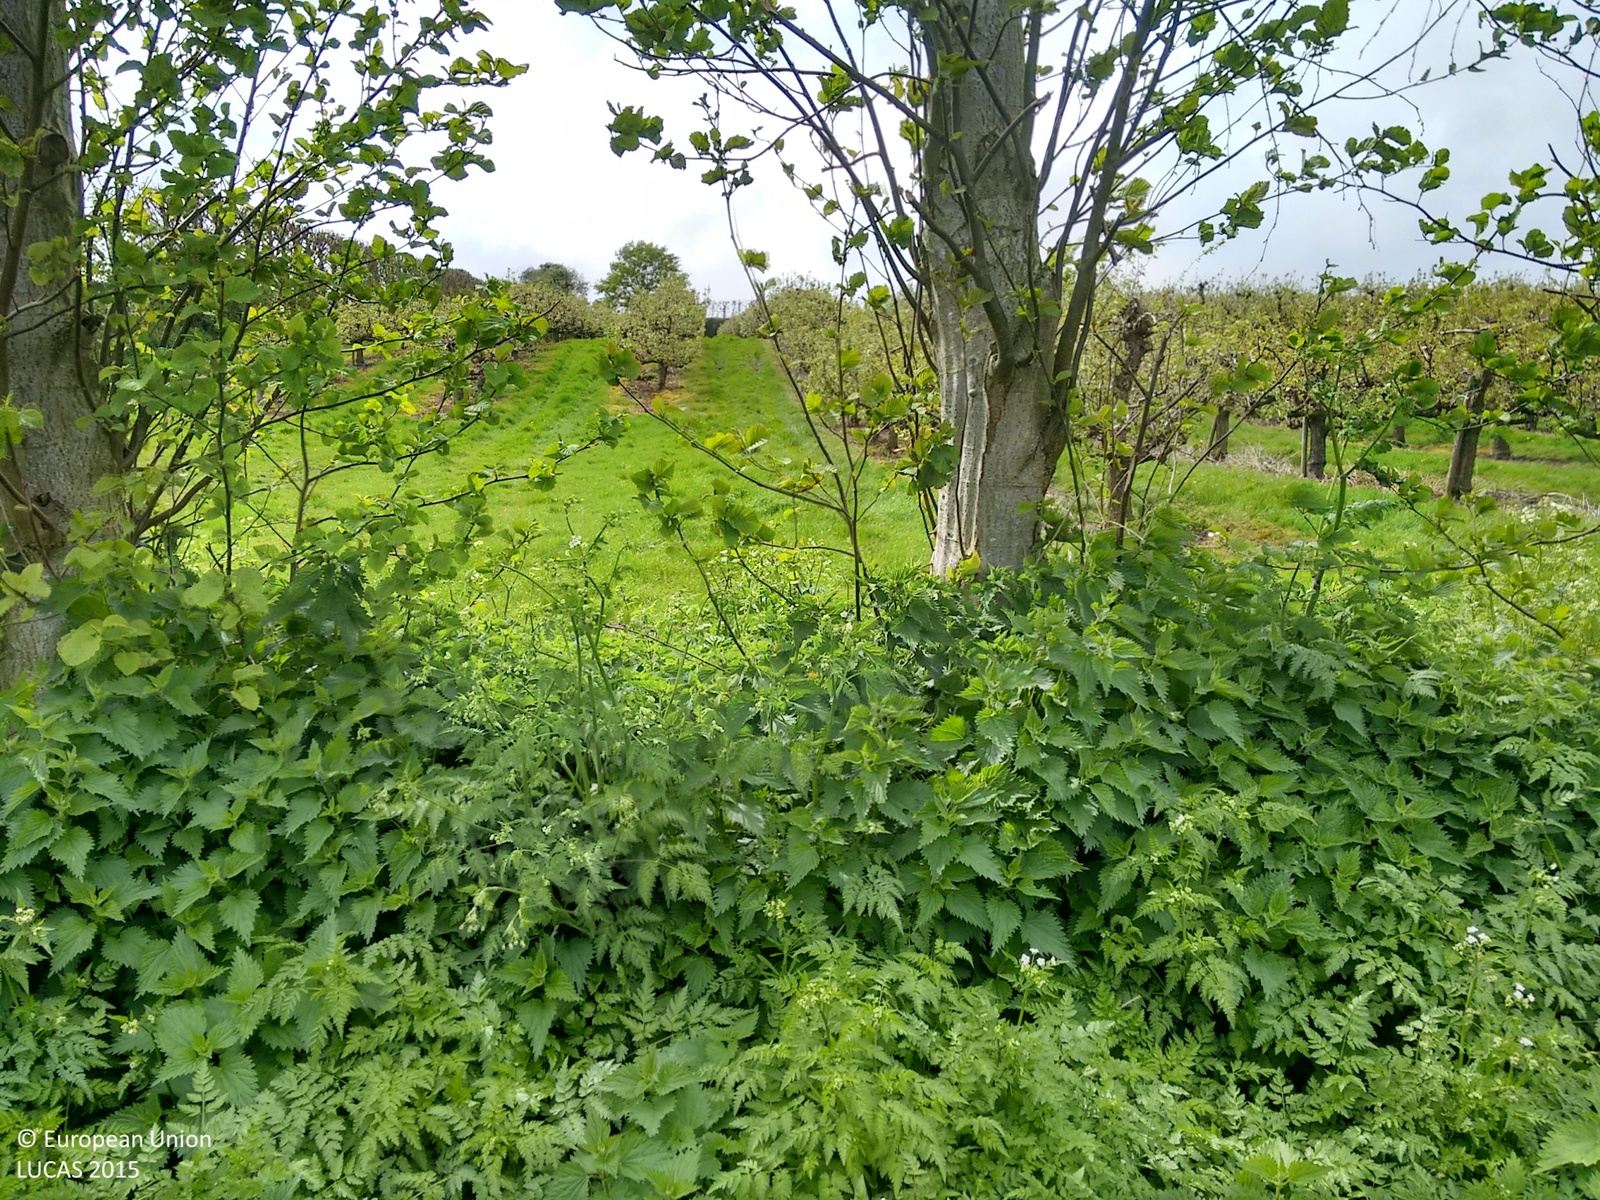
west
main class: Cropland
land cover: Pear fruit
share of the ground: 50 - 75 %
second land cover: Grassland without tree/shrub cover
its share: 50 - 75 %
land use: Agriculture (excluding fallow land and kitchen gardens)
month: May
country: GB
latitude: 51.2726
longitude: 0.2946
